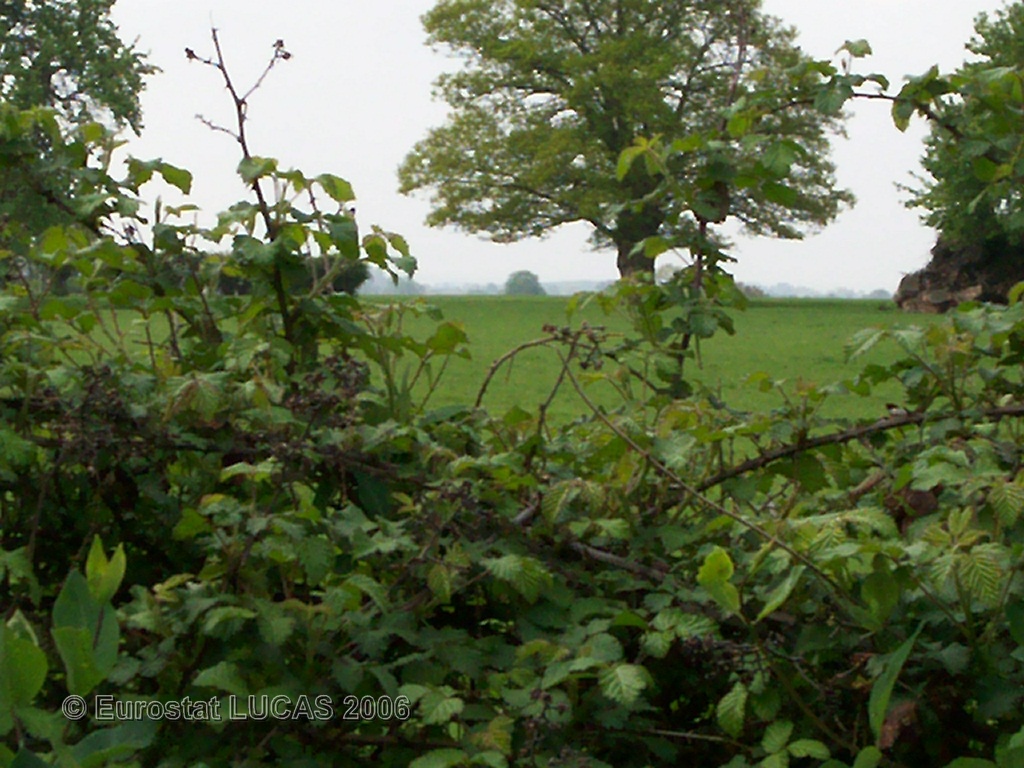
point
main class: Grassland
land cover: Grassland without tree/shrub cover
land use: Agriculture (excluding fallow land and kitchen gardens)
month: May
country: FR
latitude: 48.5096
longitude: 0.1855
